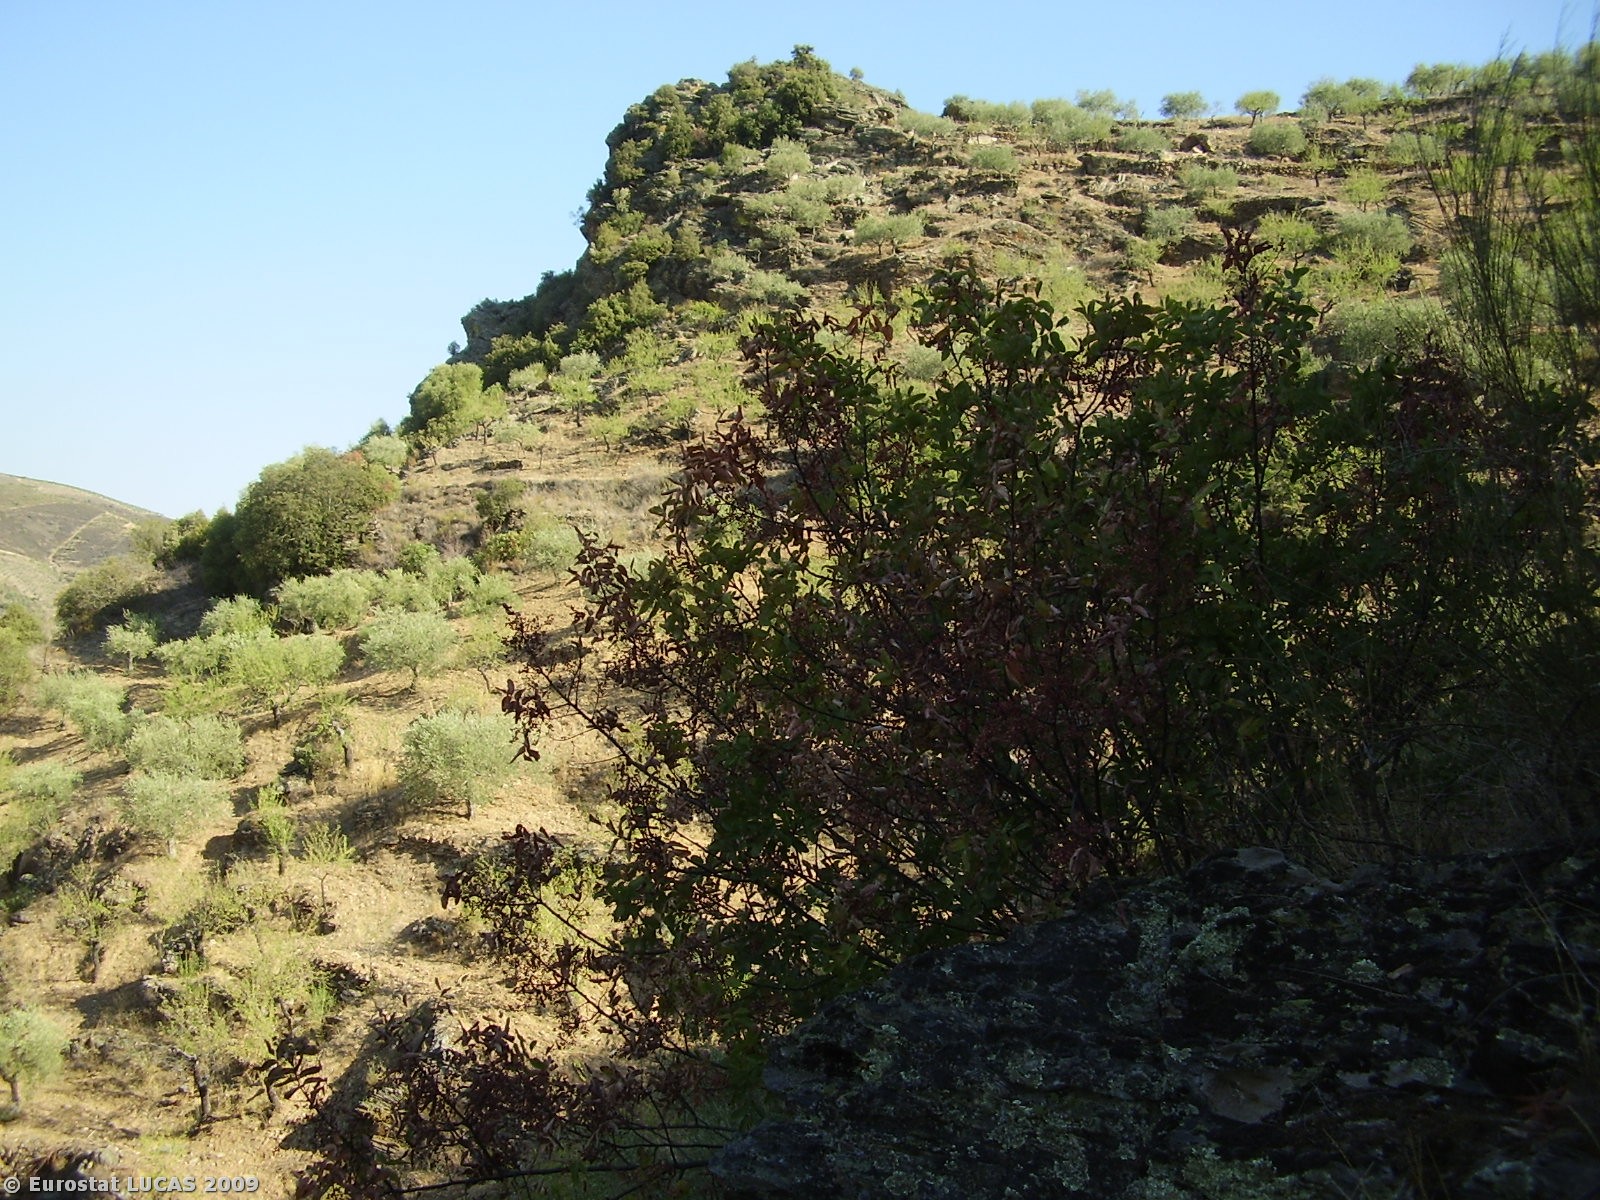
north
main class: Shrubland
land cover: Shrubland with sparse tree cover
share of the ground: > 75 %
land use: Fallow land
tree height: > 5 m
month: August
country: PT
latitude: 41.3271
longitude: -6.8226
